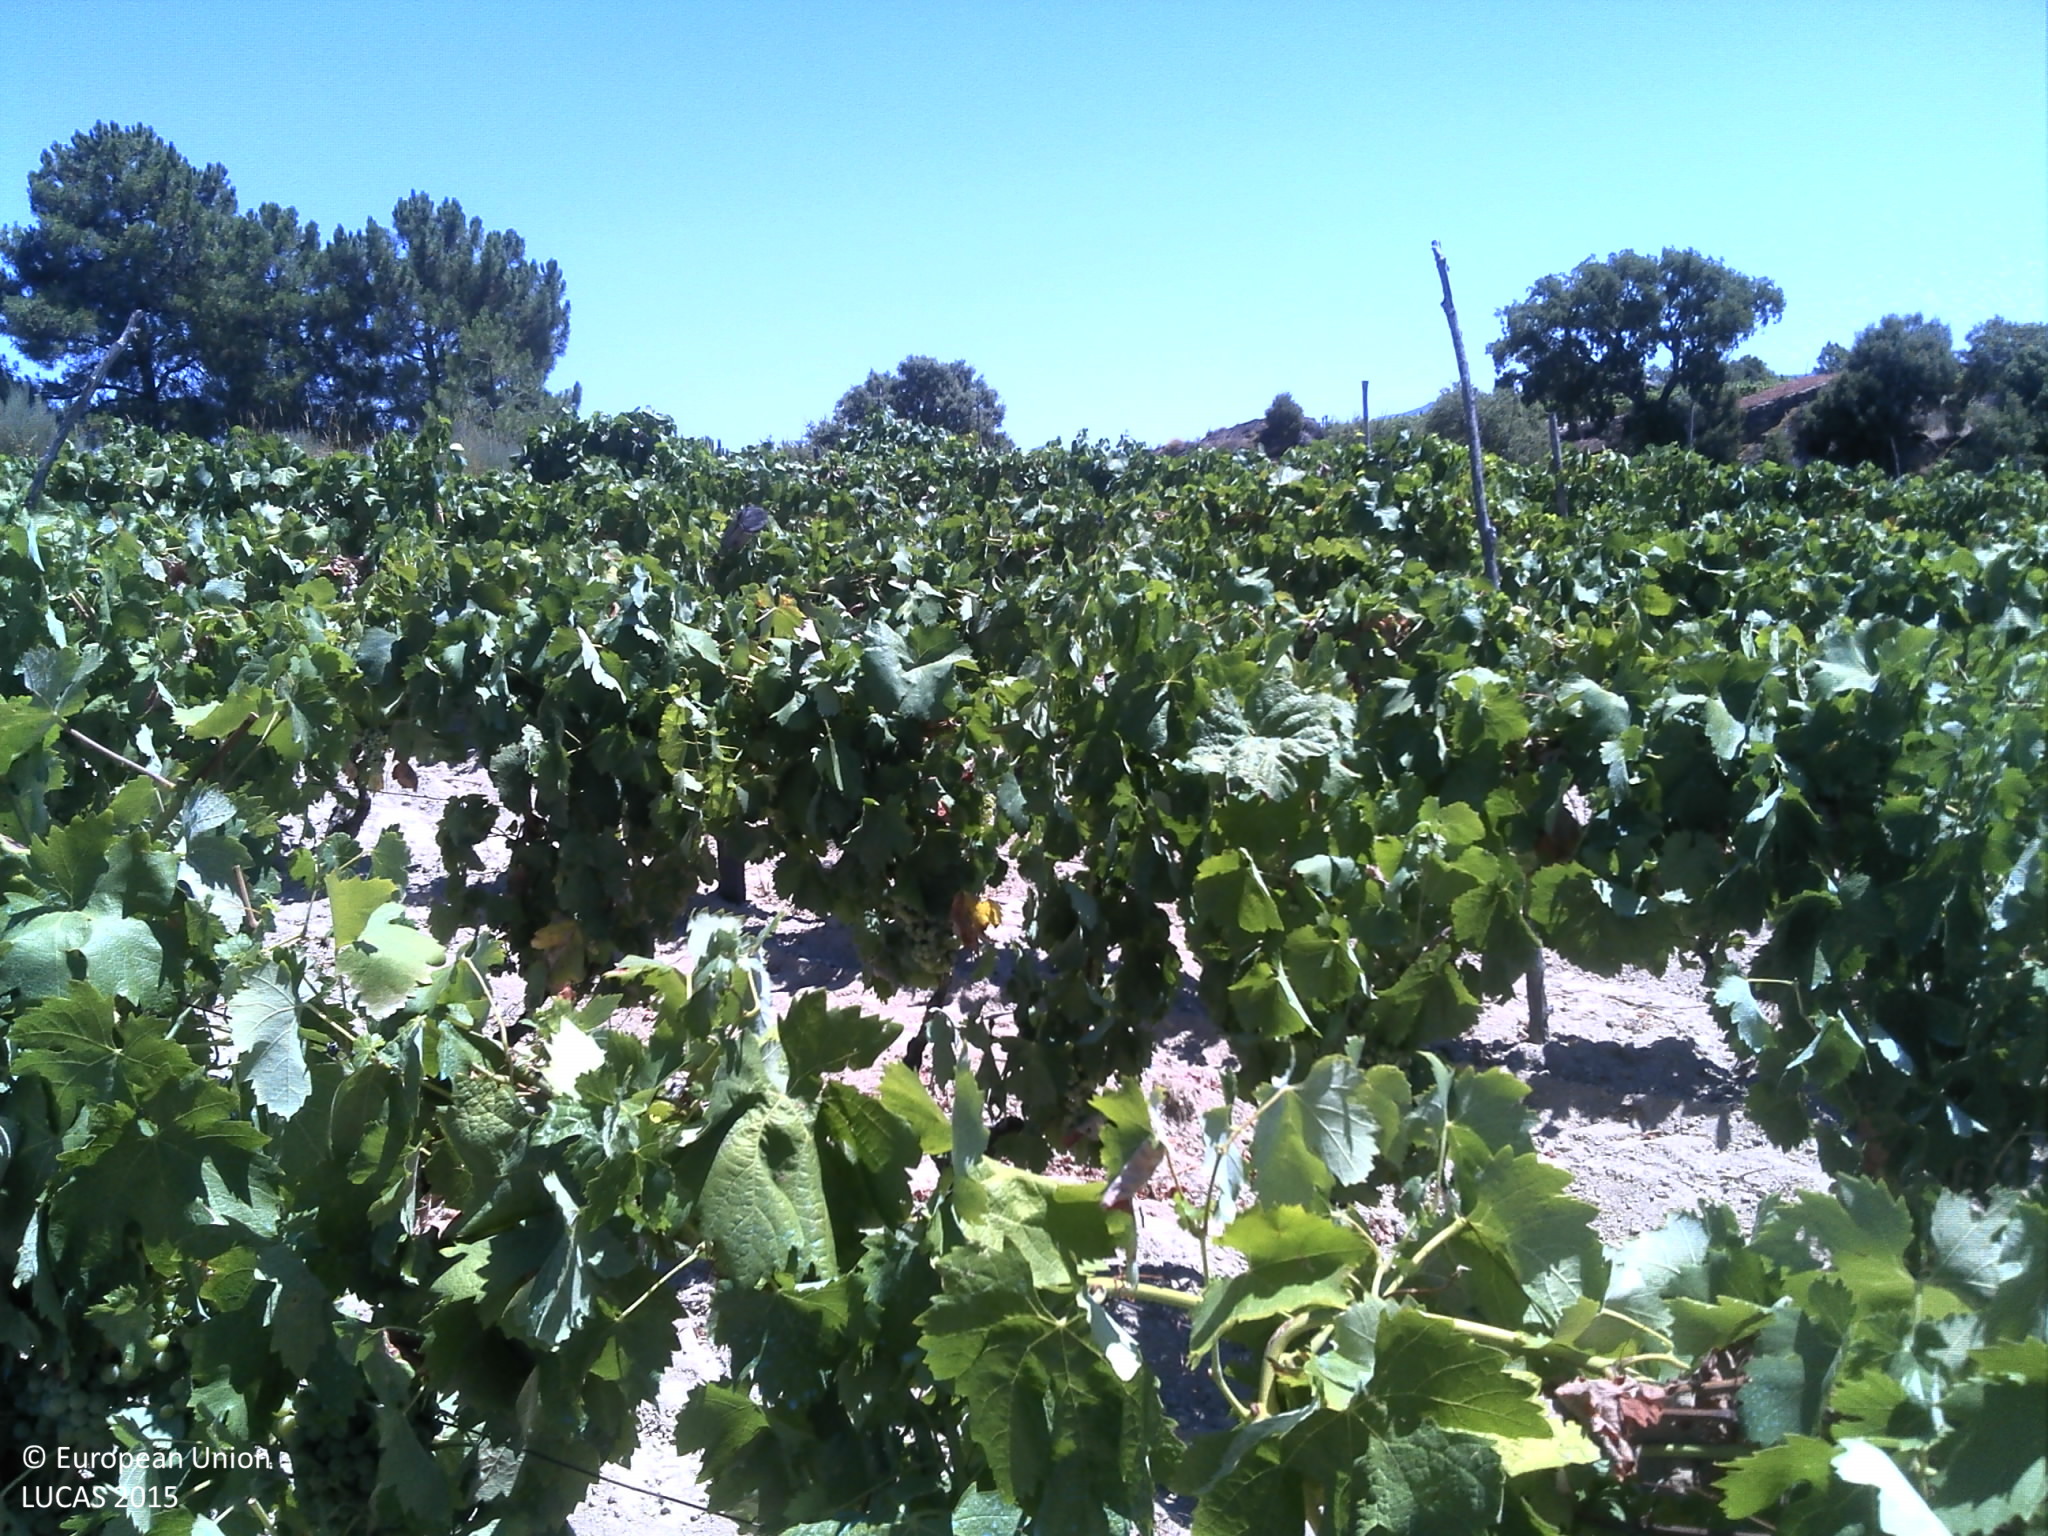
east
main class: Cropland
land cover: Vineyards
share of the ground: 10 - 25 %
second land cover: Other bare soil
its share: > 75 %
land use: Agriculture (excluding fallow land and kitchen gardens)
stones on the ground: 25 - 50 %
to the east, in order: Vineyards; Other bare soil; Rock outcrops; Shrubland with sparse tree cover; Dry stone walls; Olive groves; Other bare soil; Vineyards; Dry stone walls; Vineyards; Rock outcrops; Other coniferous woodland; Dry stone walls; Other coniferous woodland; Dry stone walls; Other coniferous woodland; Dry stone walls; Other coniferous woodland; Dry stone walls; Olive groves; Dry stone walls; Other coniferous woodland; Dry stone walls; Other coniferous woodland; Dry stone walls; Other coniferous woodland; Dry stone walls; Other coniferous woodland
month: July
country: PT
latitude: 41.1963
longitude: -7.1529
